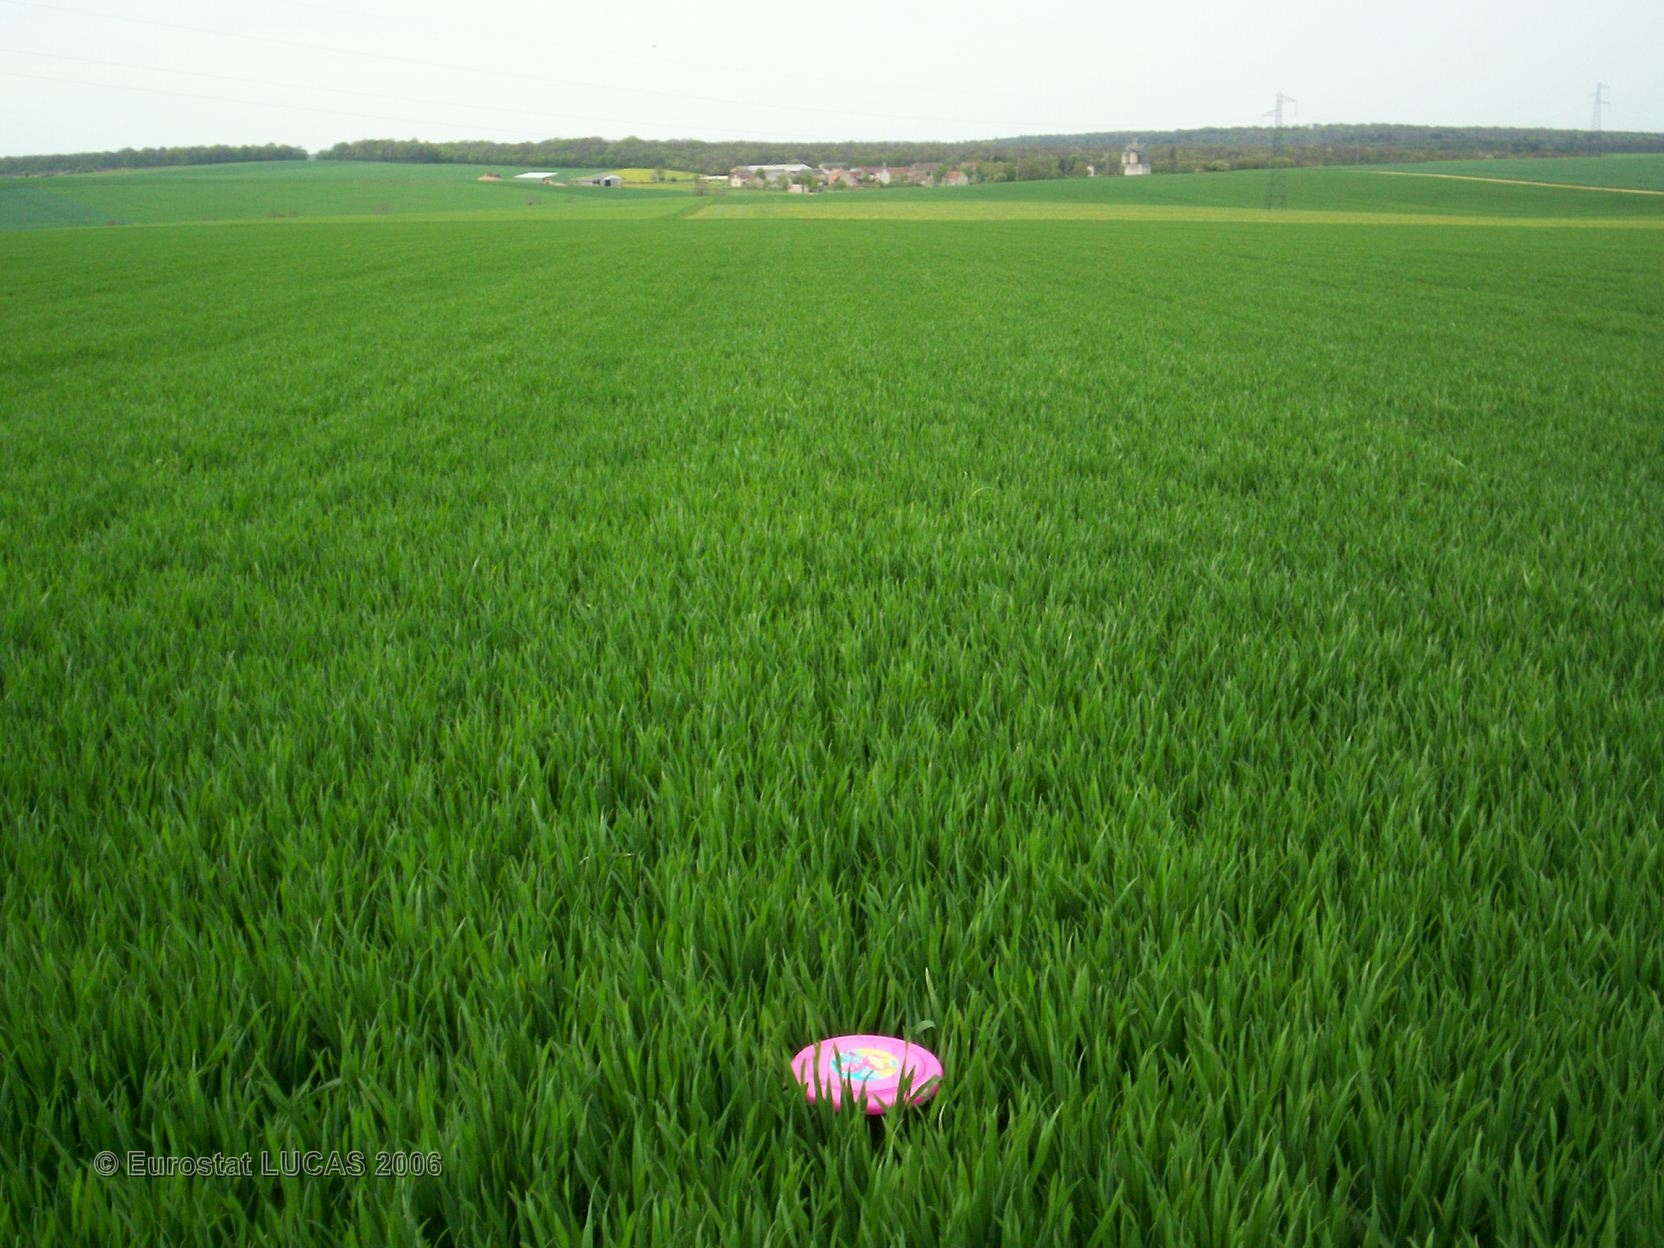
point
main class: Cropland
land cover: Common wheat
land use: Agriculture (excluding fallow land and kitchen gardens)
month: May
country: FR
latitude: 47.6368
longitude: 4.5286
